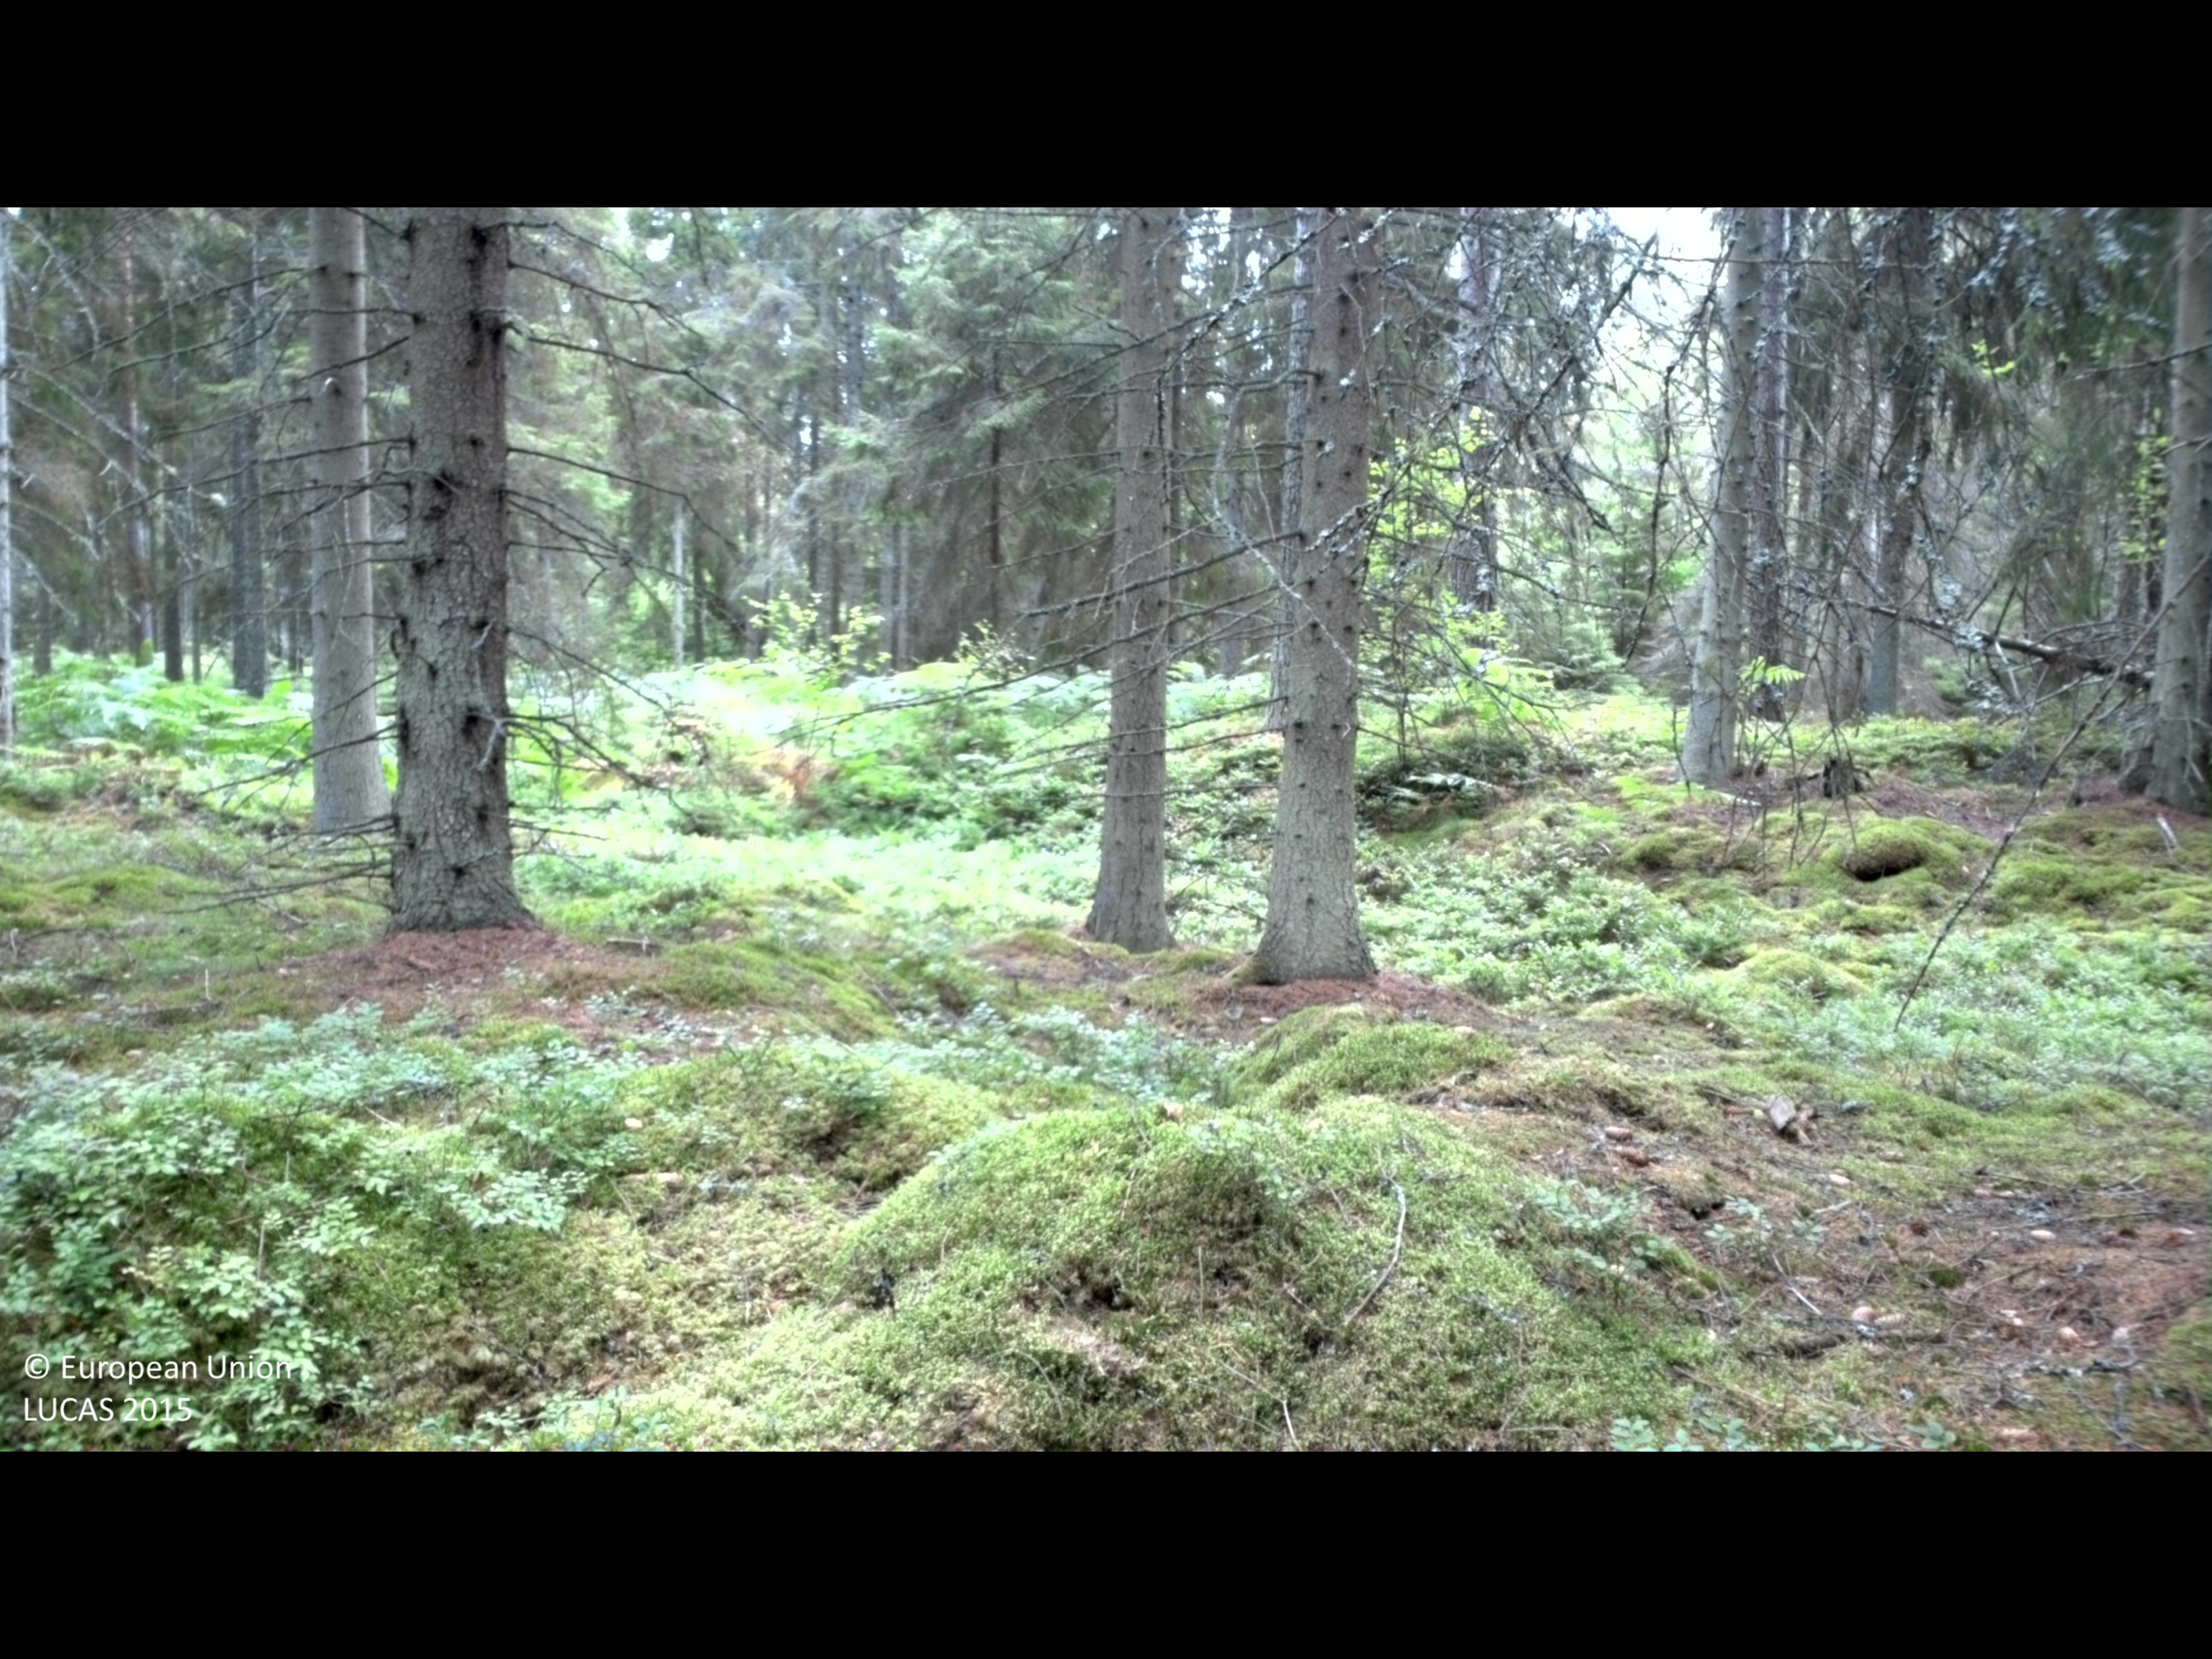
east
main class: Woodland
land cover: Spruce dominated coniferous woodland
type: boreal forest
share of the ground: > 75 %
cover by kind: coniferous forest trees 75 %, shrubs 15 %, herbaceous plants 5 %, lichens and mosses 5 %
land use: Forestry
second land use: Amenities, museums, leisure
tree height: > 5 m
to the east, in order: Spruce dominated coniferous woodland; Pine dominated mixed woodland; Shrubland without tree cover
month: July
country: SE
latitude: 57.2937
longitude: 17.0541
